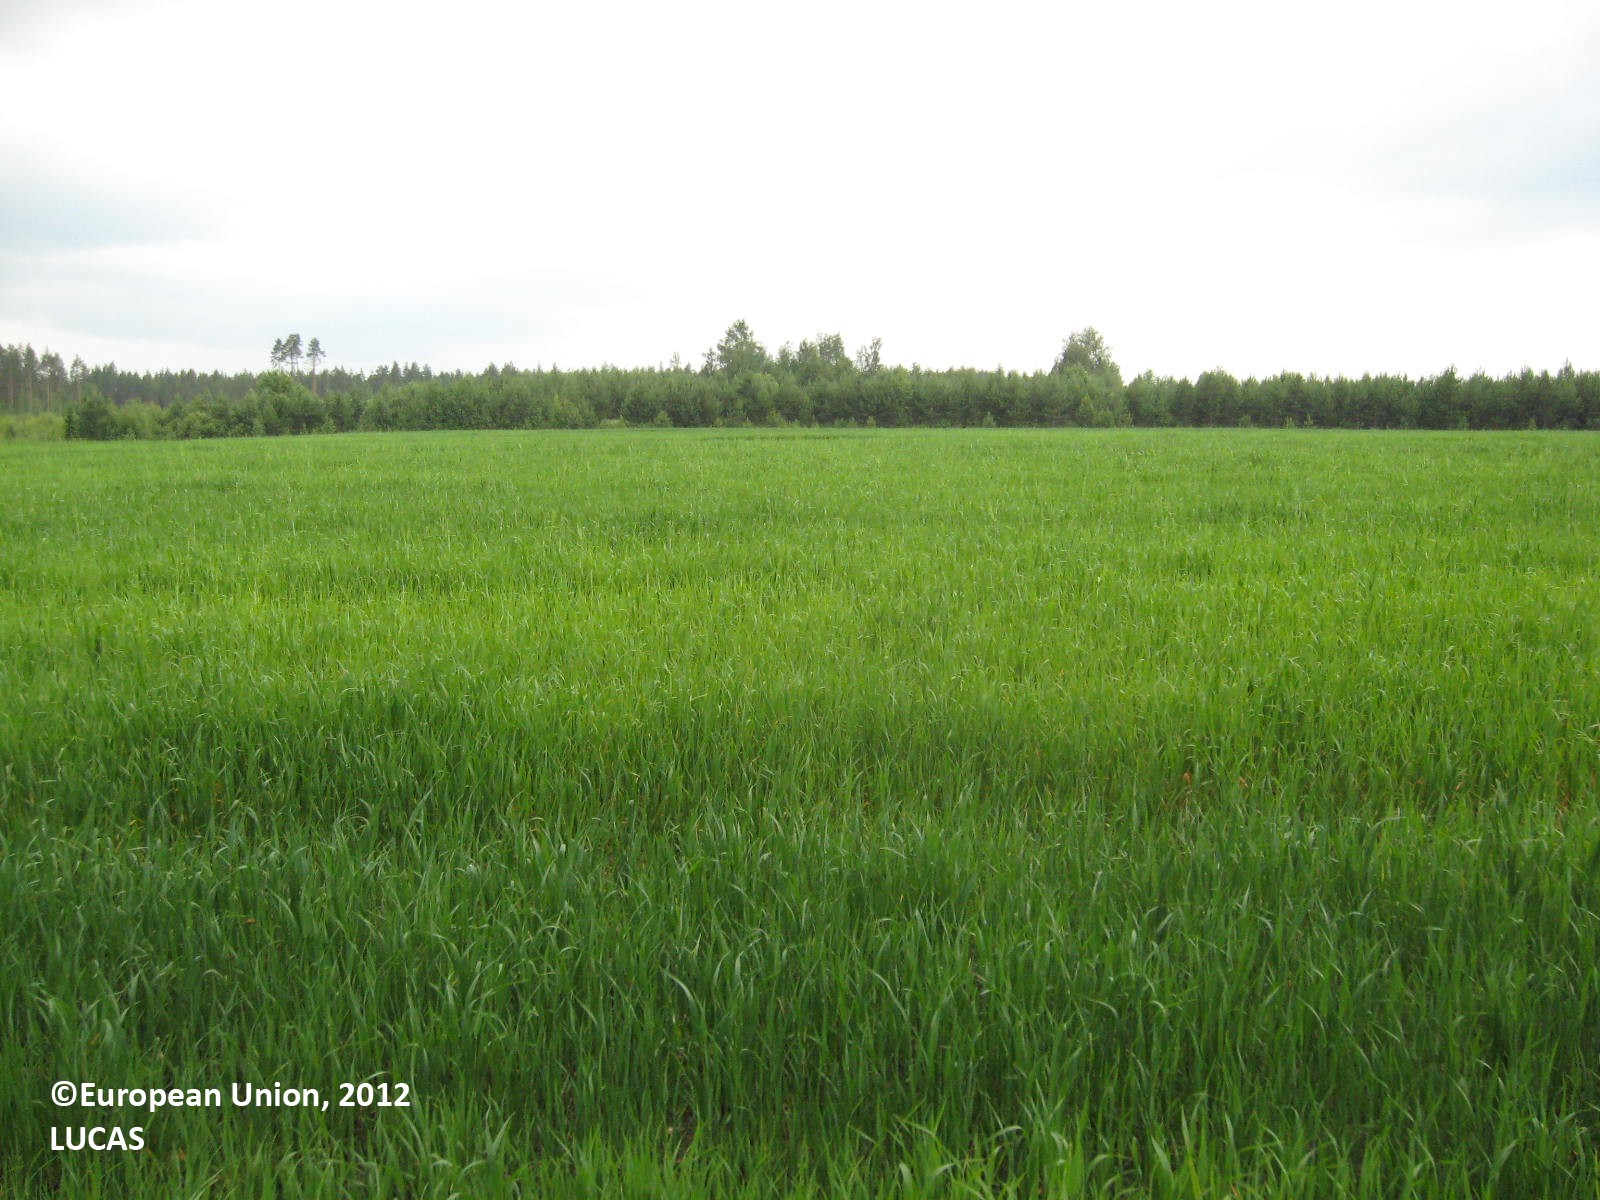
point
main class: Cropland
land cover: Oats
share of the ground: > 75 %
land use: Agriculture (excluding fallow land and kitchen gardens)
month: July
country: FI
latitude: 62.3811
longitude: 22.7247
